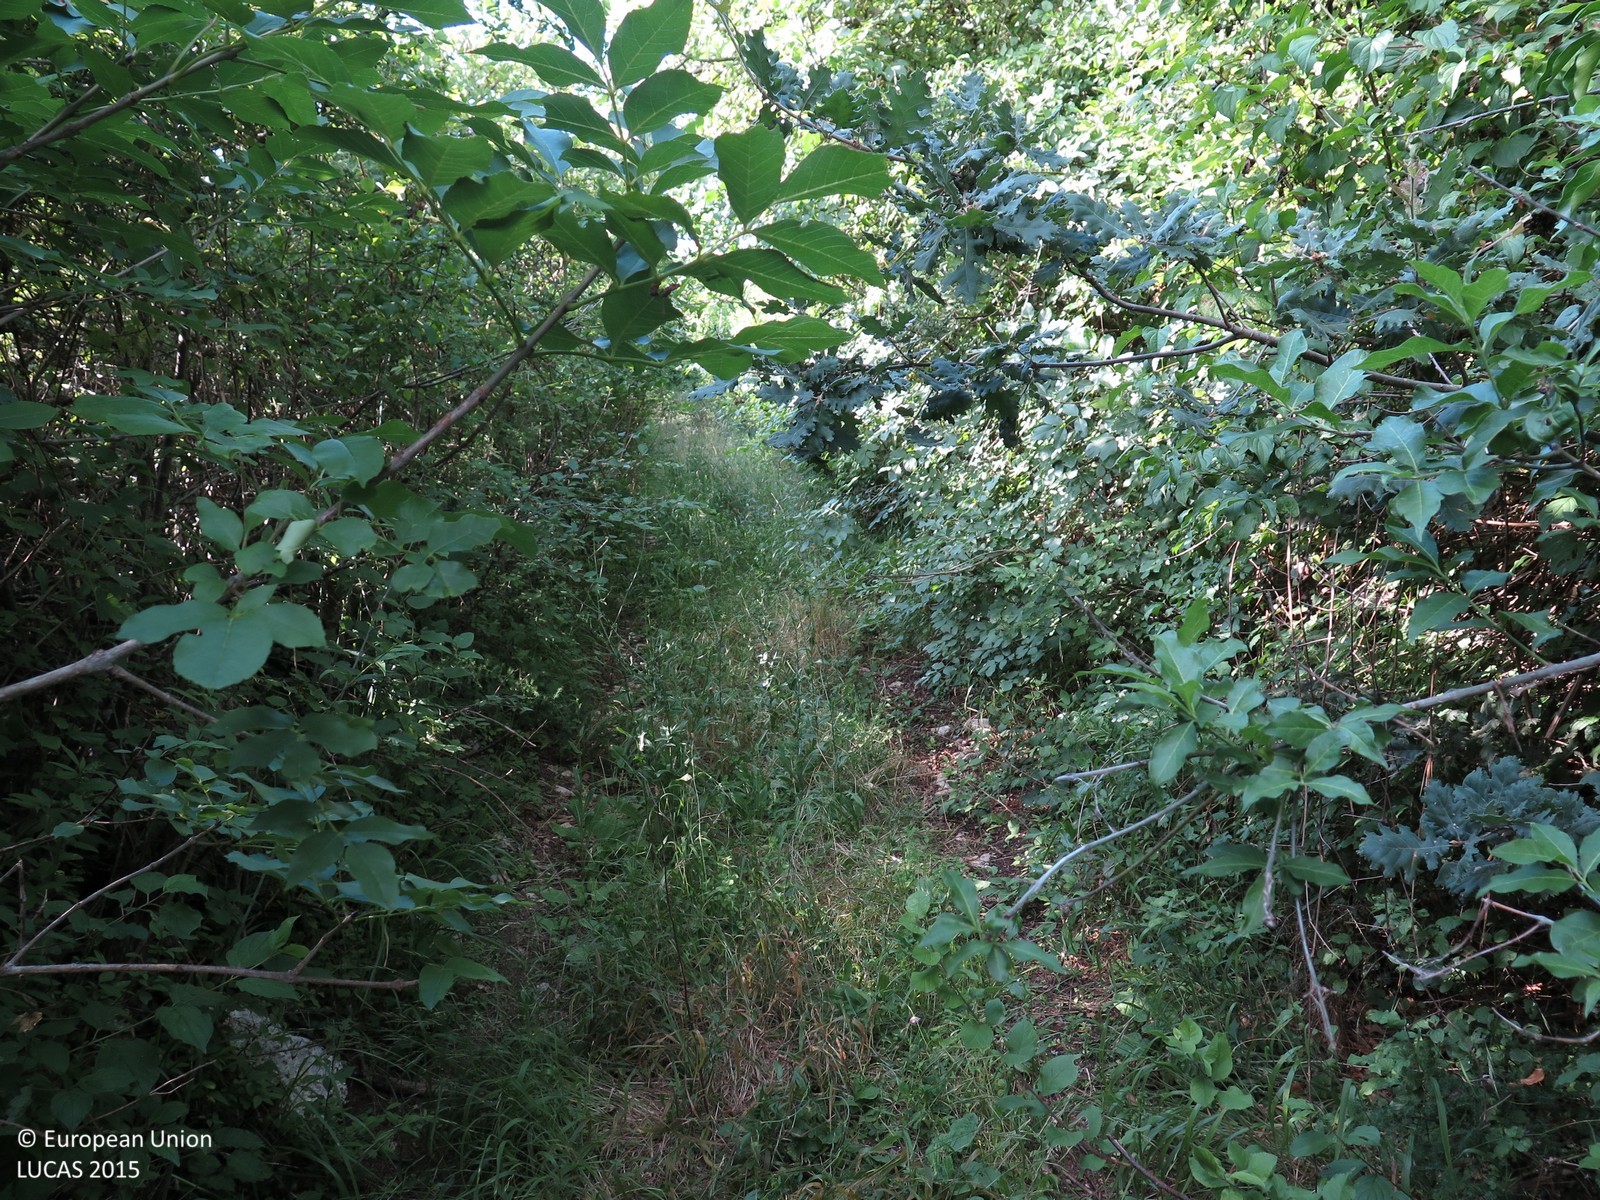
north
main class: Woodland
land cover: Broadleaved woodland
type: mesophytic deciduous forest
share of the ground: > 75 %
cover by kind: broadleaved forest trees 95 %, shrubs 5 %
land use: Semi-natural and natural areas not in use
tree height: > 5 m
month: June
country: HR
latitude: 45.1456
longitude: 13.8482
